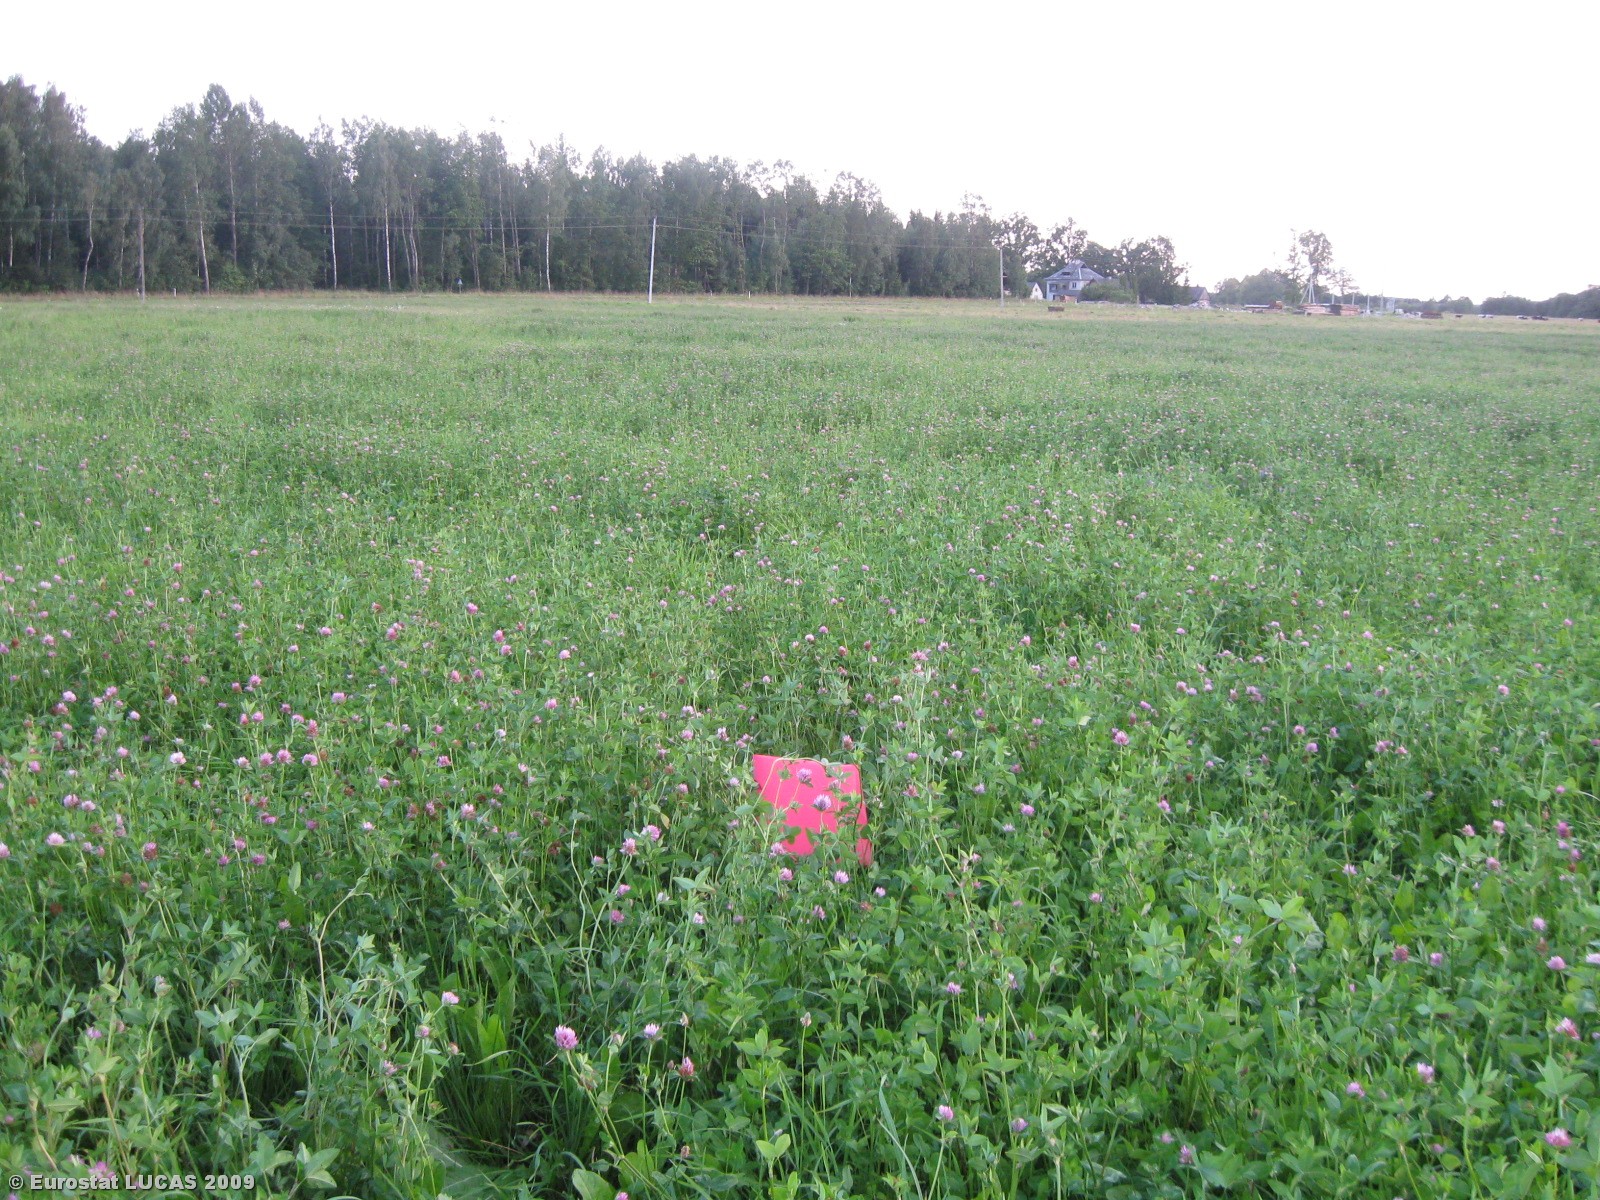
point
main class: Cropland
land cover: Clovers
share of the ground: > 75 %
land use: Agriculture (excluding fallow land and kitchen gardens)
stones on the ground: < 10 %
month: July
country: LT
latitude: 55.2649
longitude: 22.6699
